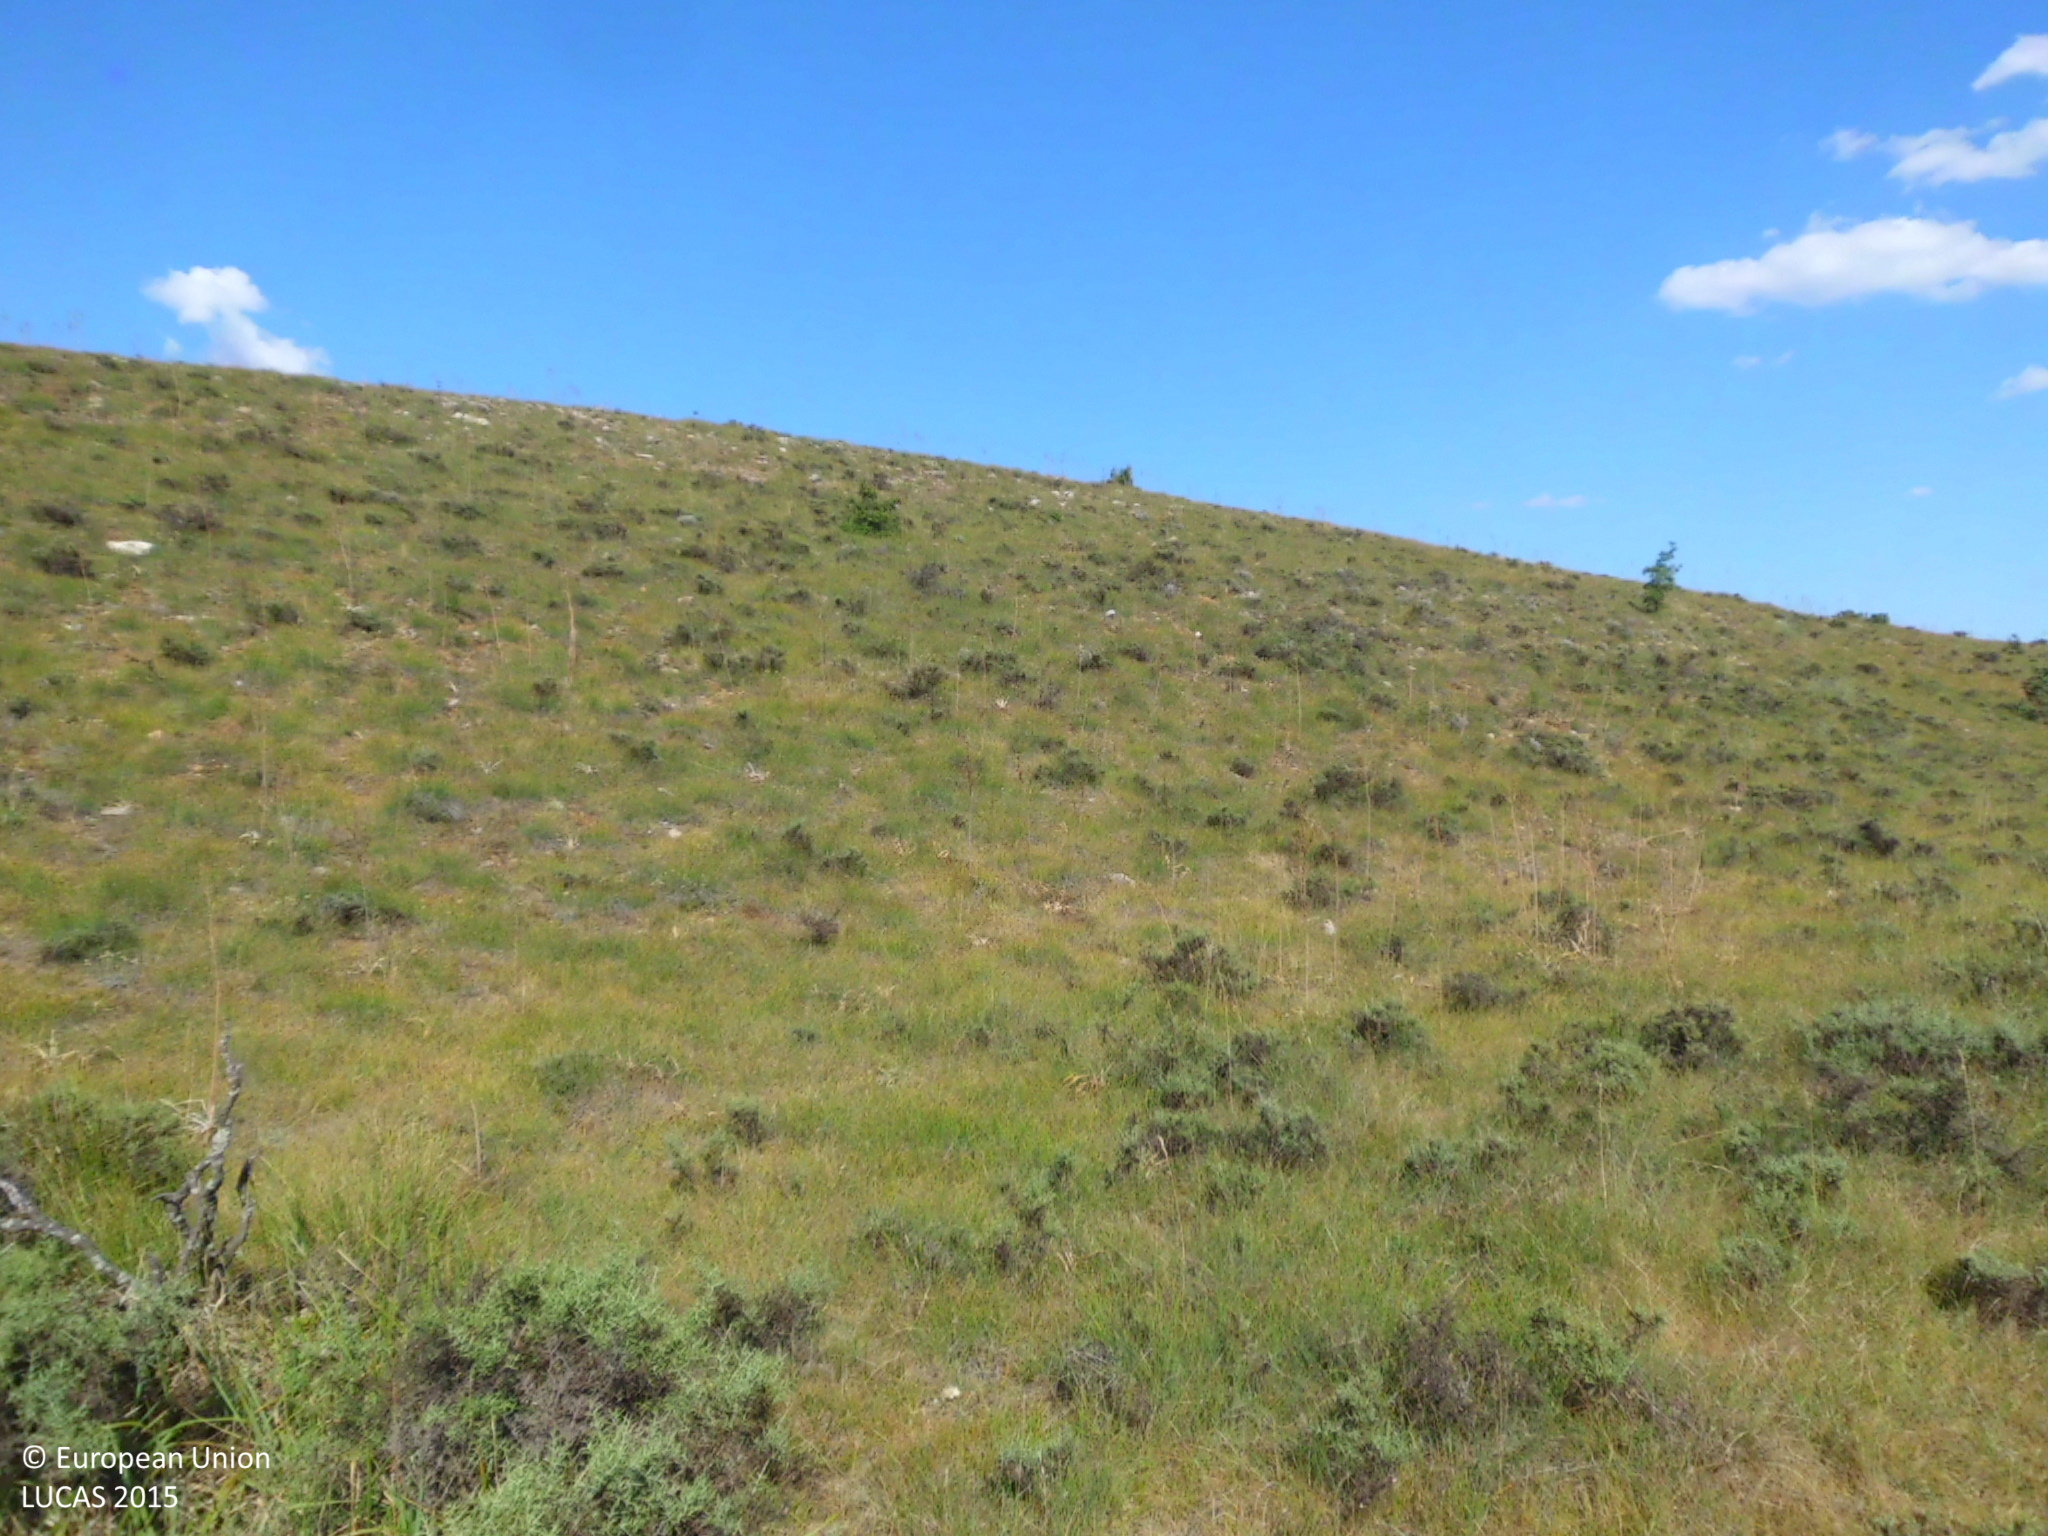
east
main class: Grassland
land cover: Grassland without tree/shrub cover
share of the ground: > 75 %
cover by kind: herbaceous plants 95 %, shrubs 5 %
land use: Agriculture (excluding fallow land and kitchen gardens)
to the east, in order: Grassland without tree/shrub cover
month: July
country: ES
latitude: 42.8273
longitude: -4.4016
